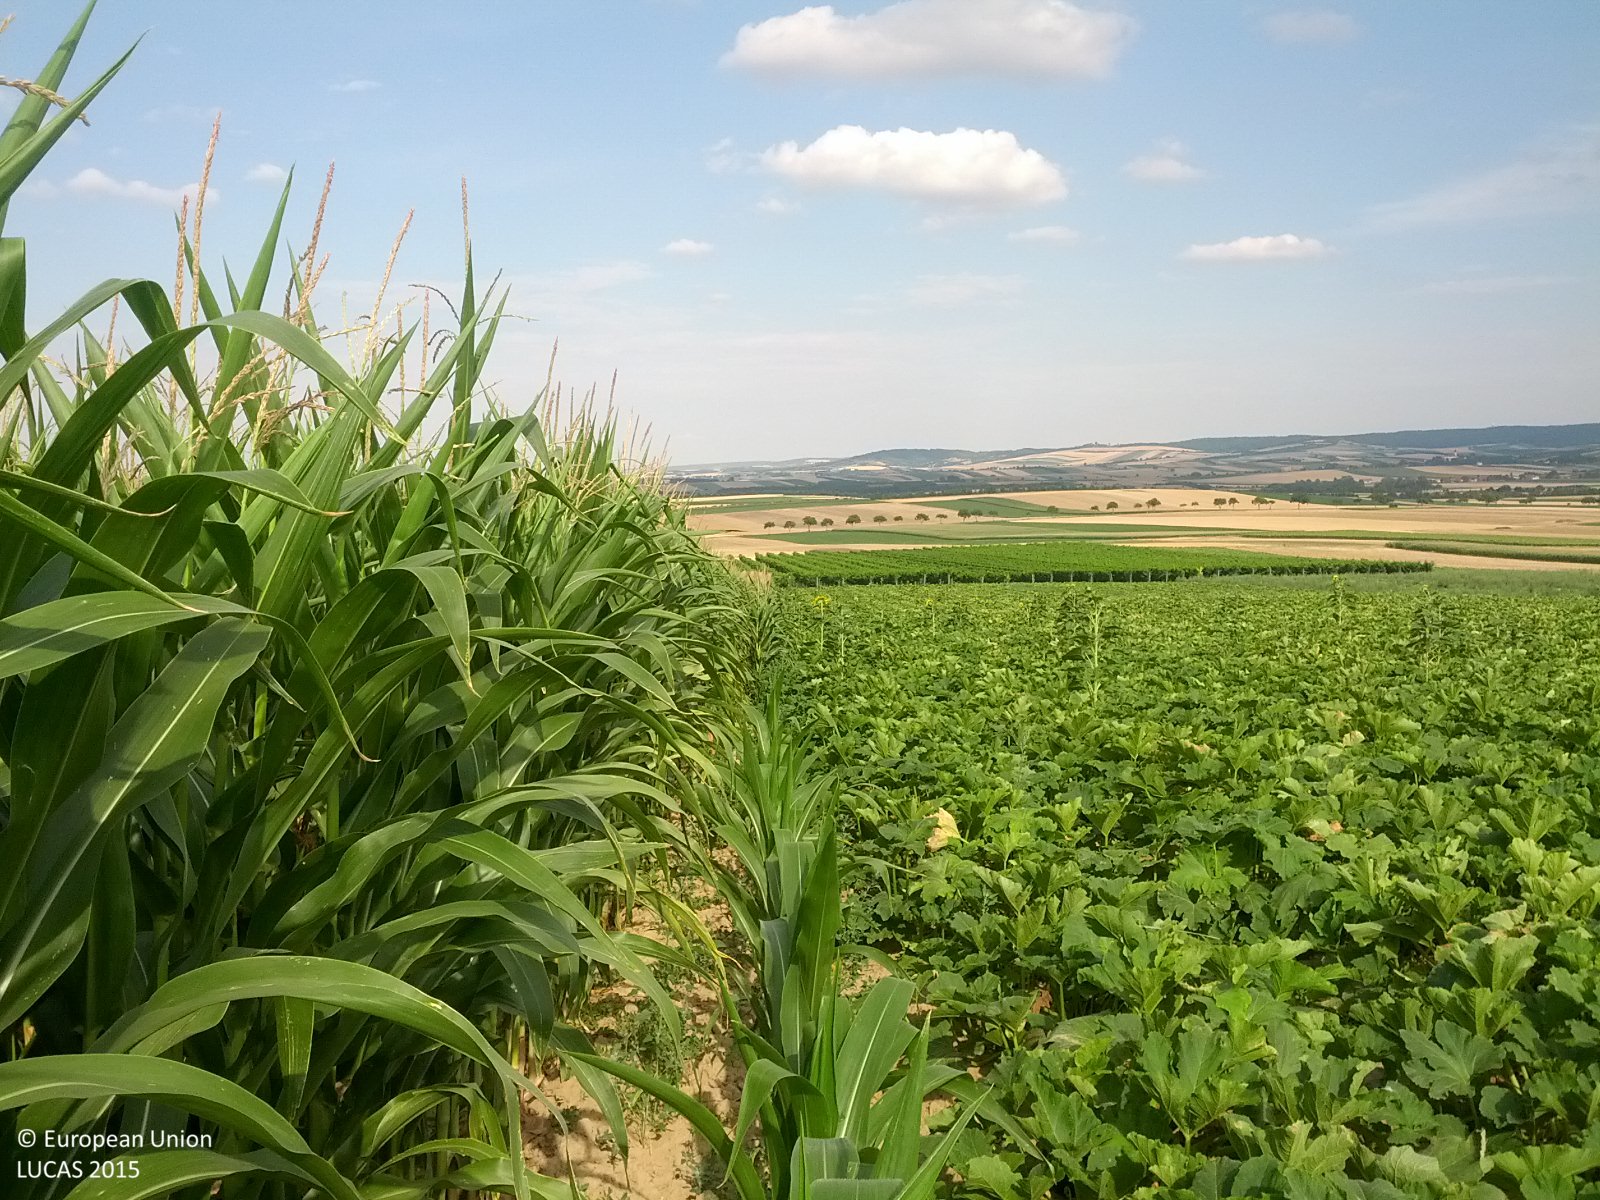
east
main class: Cropland
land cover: Maize
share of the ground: > 75 %
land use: Agriculture (excluding fallow land and kitchen gardens)
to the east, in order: Maize; Grass margins; Tracks; Grass margins; Vineyards
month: July
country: AT
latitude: 48.6456
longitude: 16.1806
